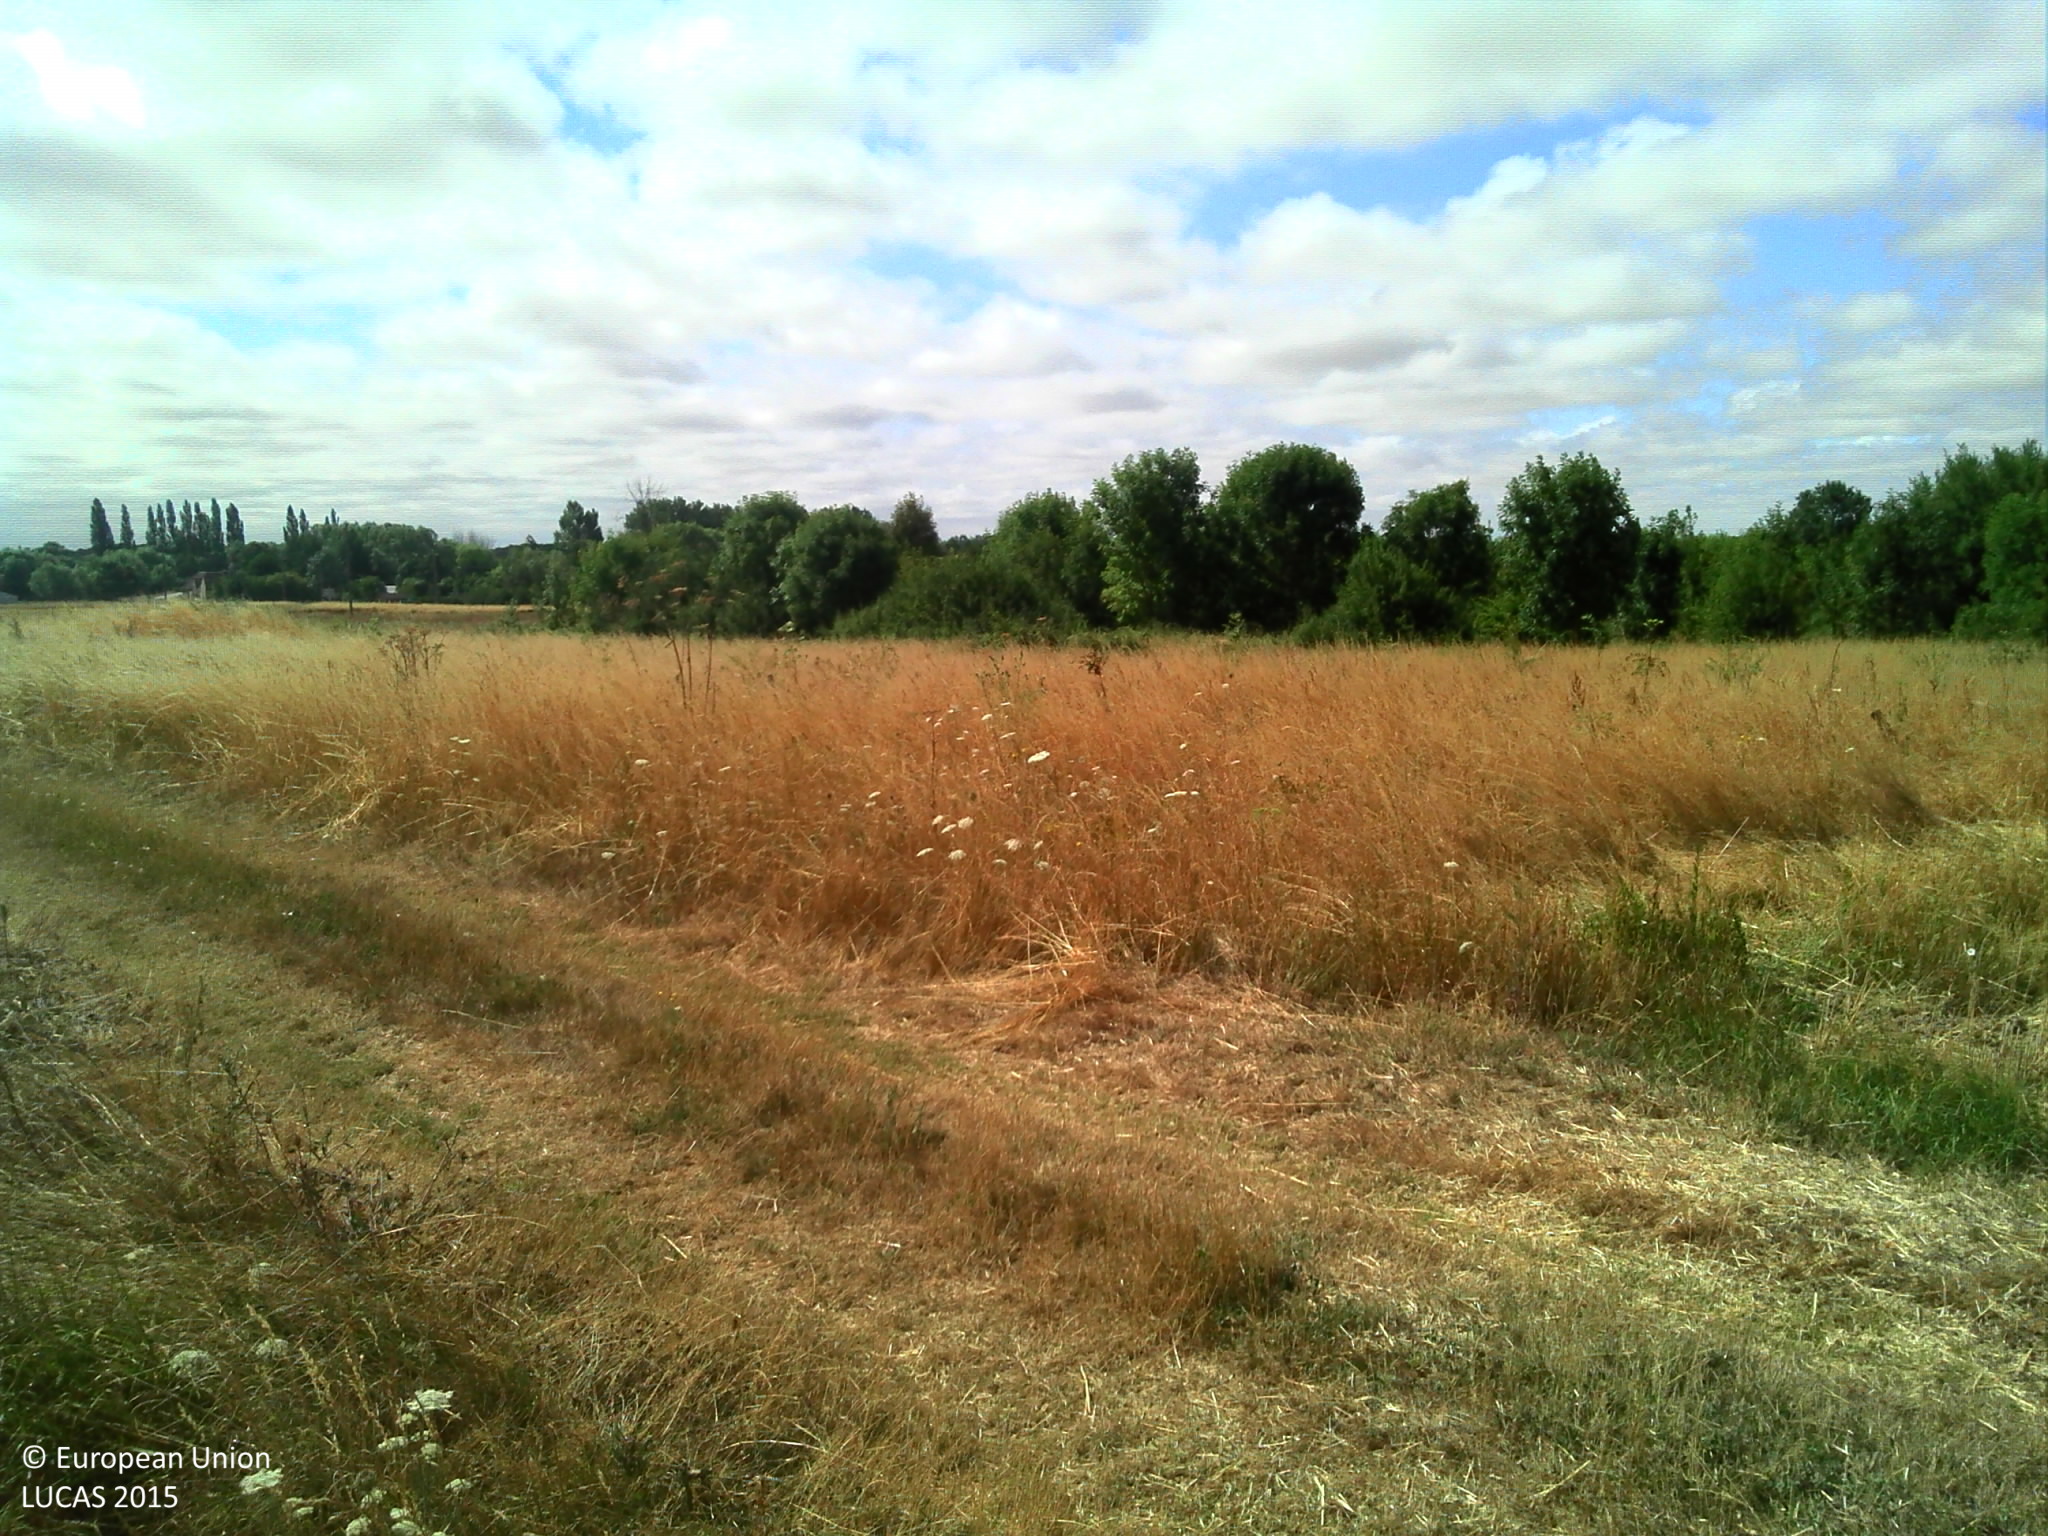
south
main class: Cropland
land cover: Barley
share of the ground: > 75 %
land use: Agriculture (excluding fallow land and kitchen gardens)
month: July
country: FR
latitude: 48.2744
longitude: 1.2643
